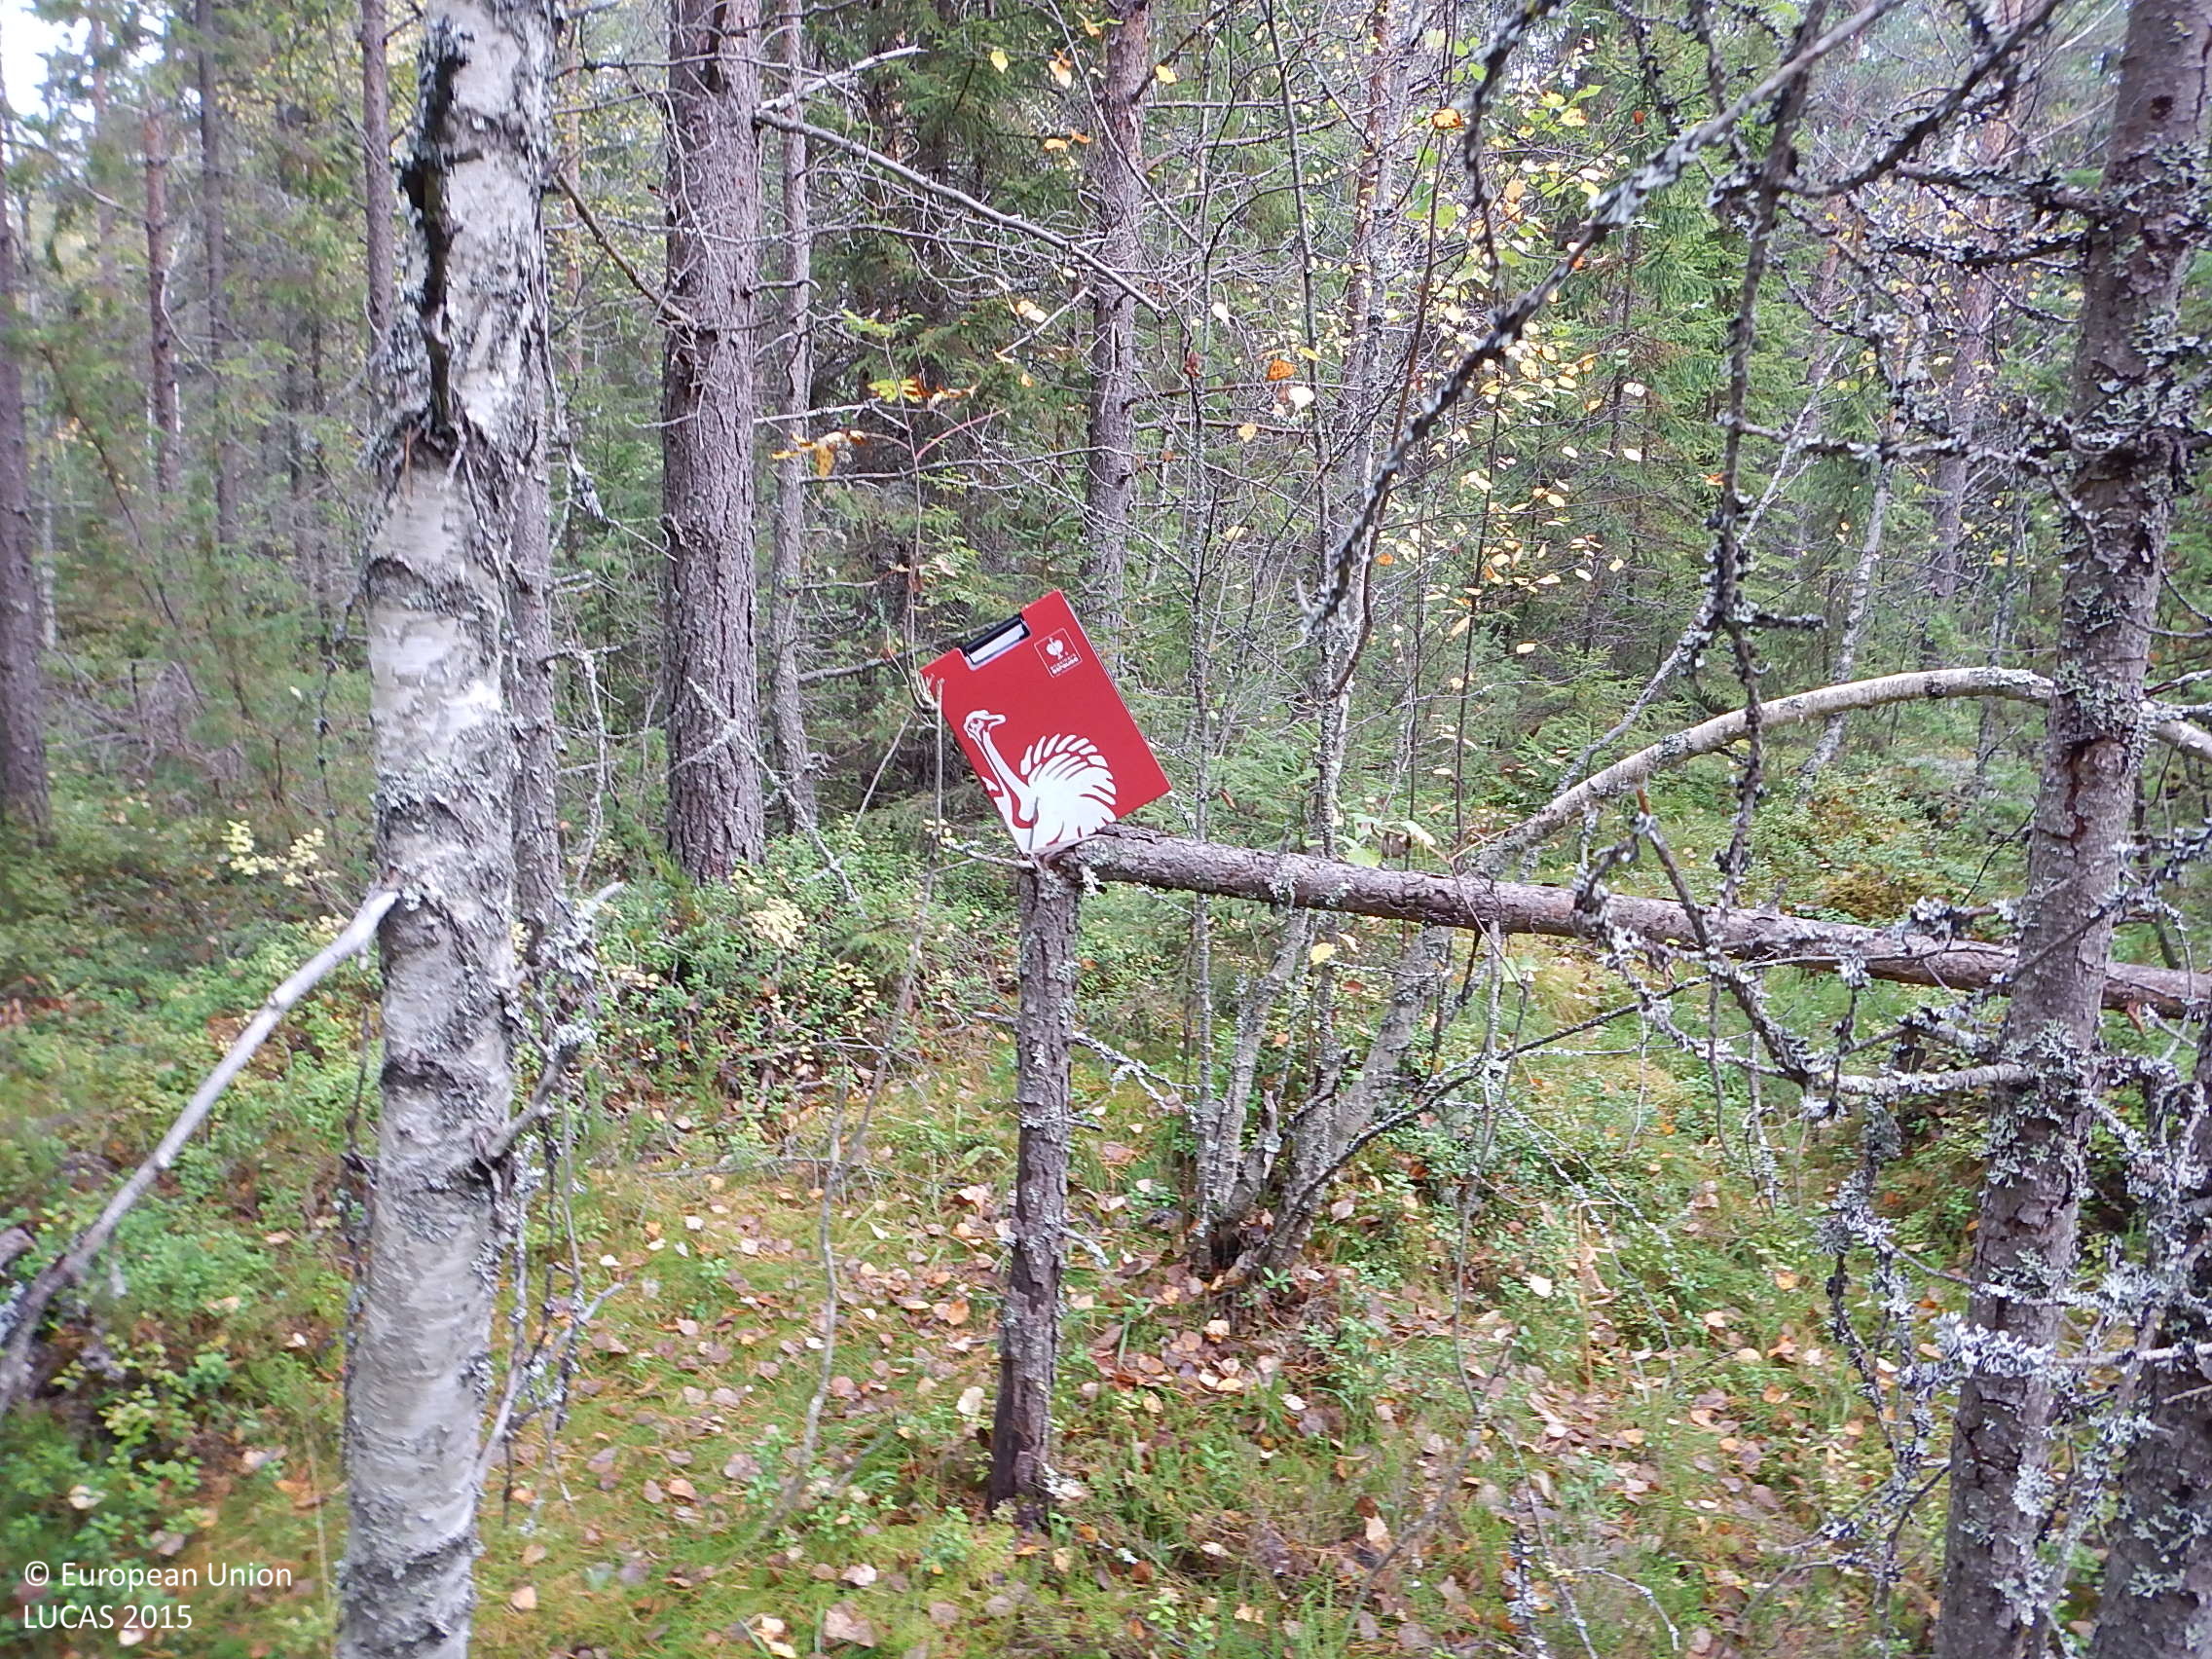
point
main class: Woodland
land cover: Other mixed woodland
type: boreal forest
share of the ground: 50 - 75 %
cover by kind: coniferous forest trees 40 %, broadleaved forest trees 25 %, shrubs 20 %, lichens and mosses 10 %, herbaceous plants 5 %
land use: Forestry
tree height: > 5 m
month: September
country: FI
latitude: 62.0016
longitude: 22.8778
